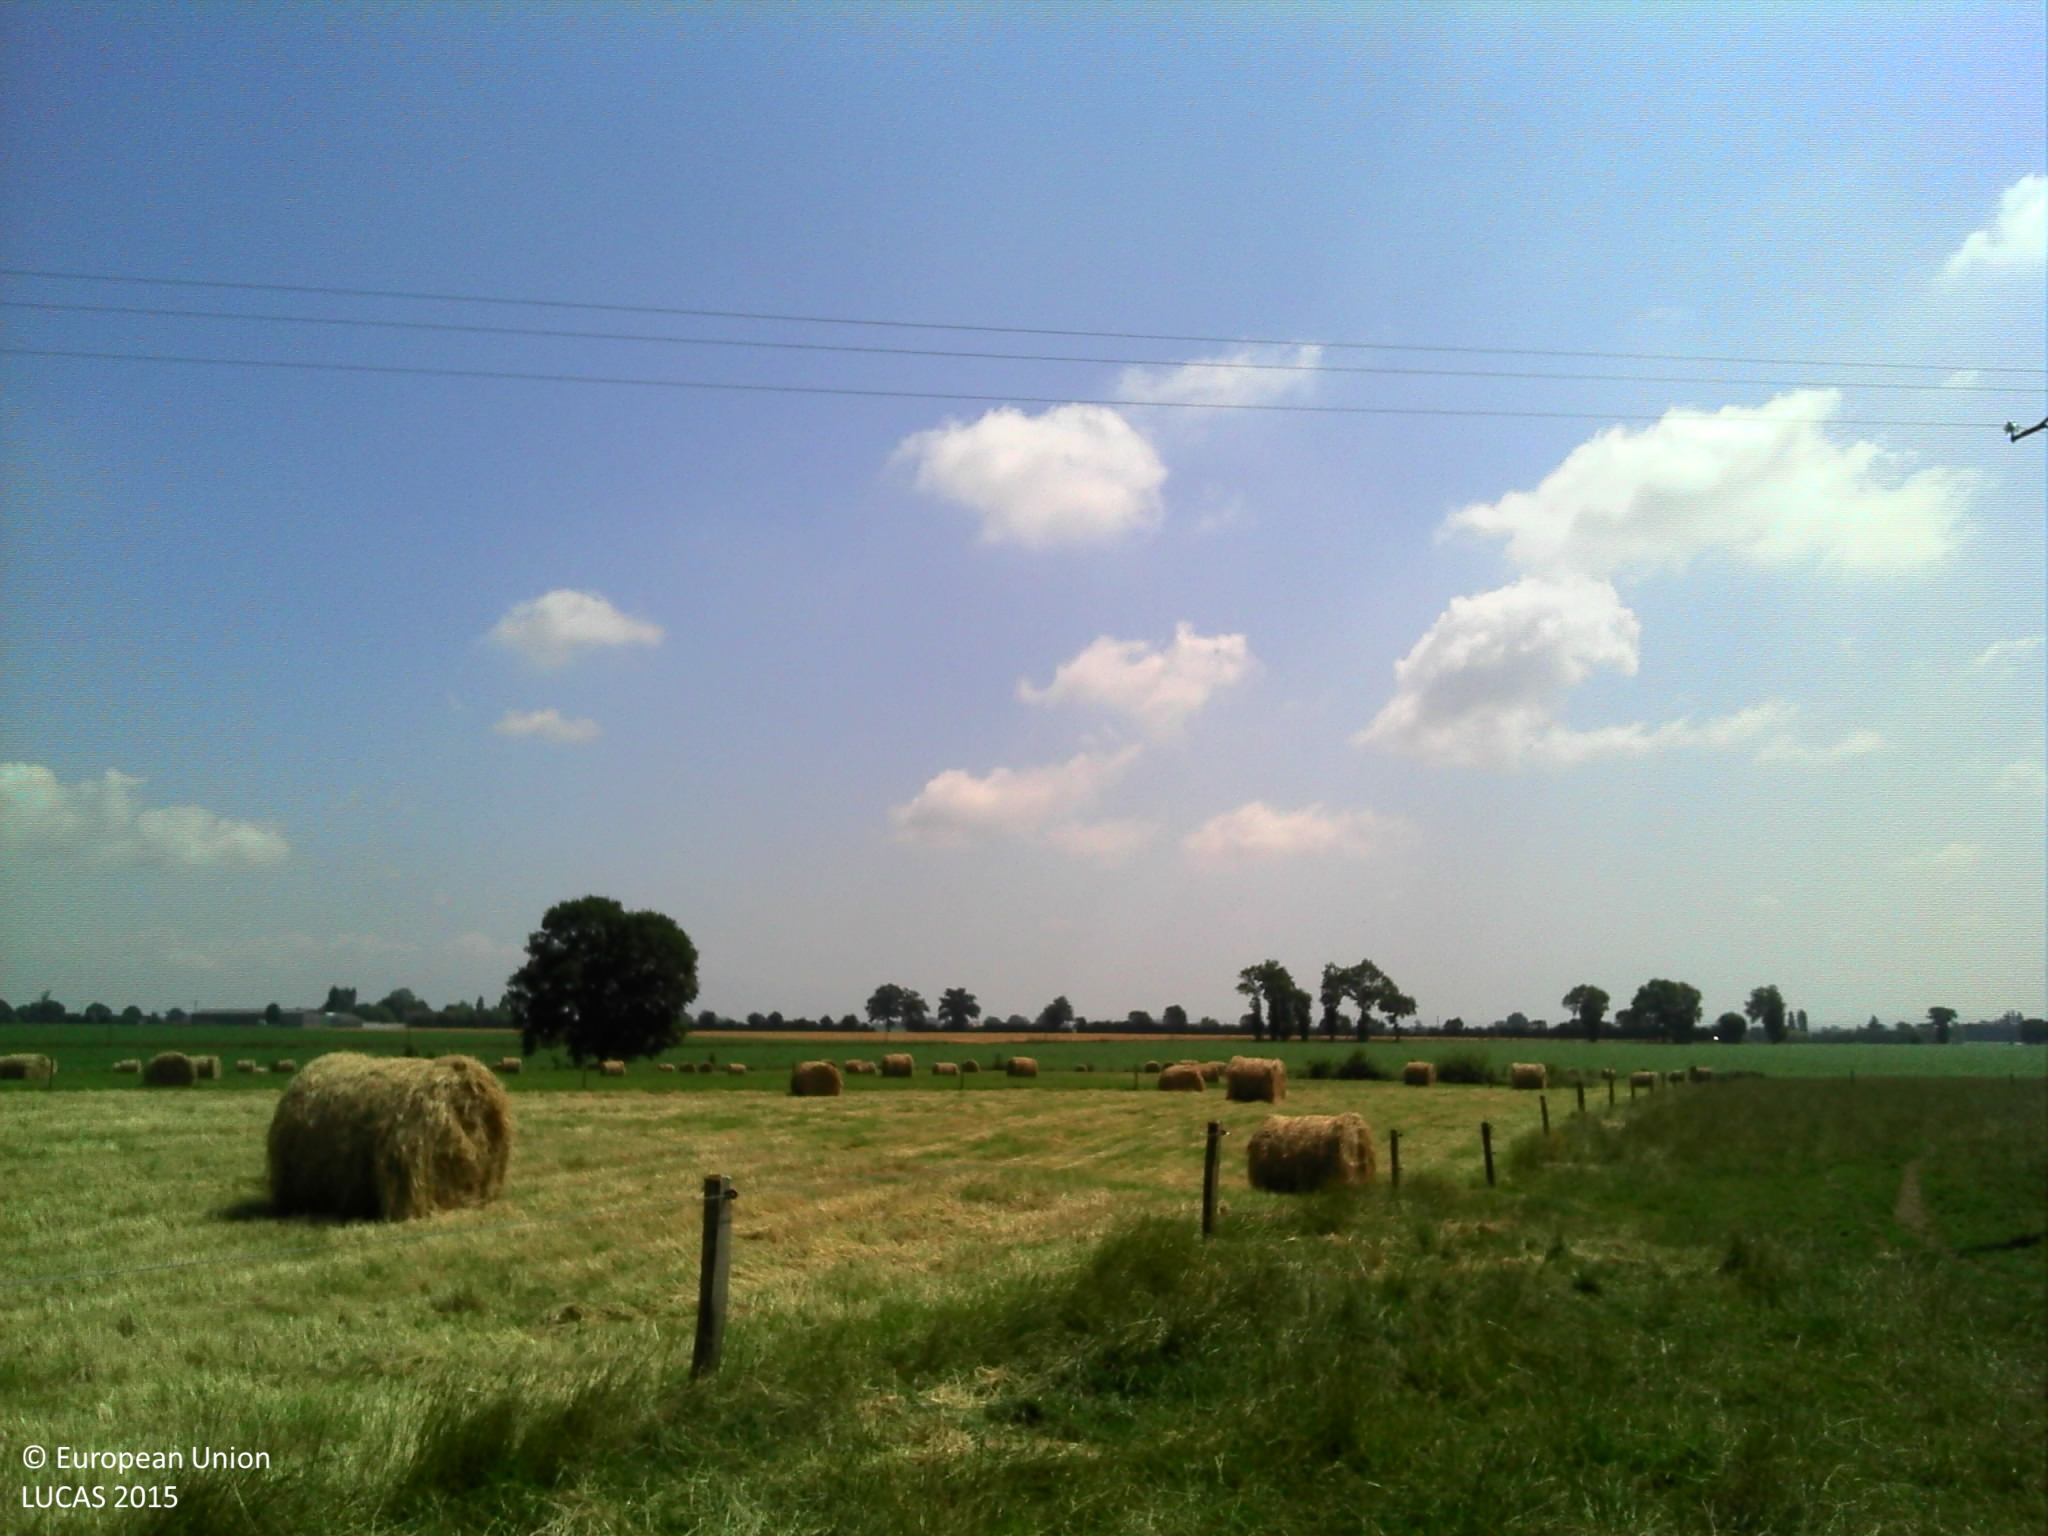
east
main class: Grassland
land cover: Grassland without tree/shrub cover
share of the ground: > 75 %
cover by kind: herbaceous plants 100 %
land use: Agriculture (excluding fallow land and kitchen gardens)
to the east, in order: Grassland without tree/shrub cover; Fences; Grassland without tree/shrub cover; Electric lines; Inland fresh water bodies; Grassland without tree/shrub cover; Fences; Ditches and canals; Maize
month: June
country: FR
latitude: 48.2448
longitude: 0.2646
